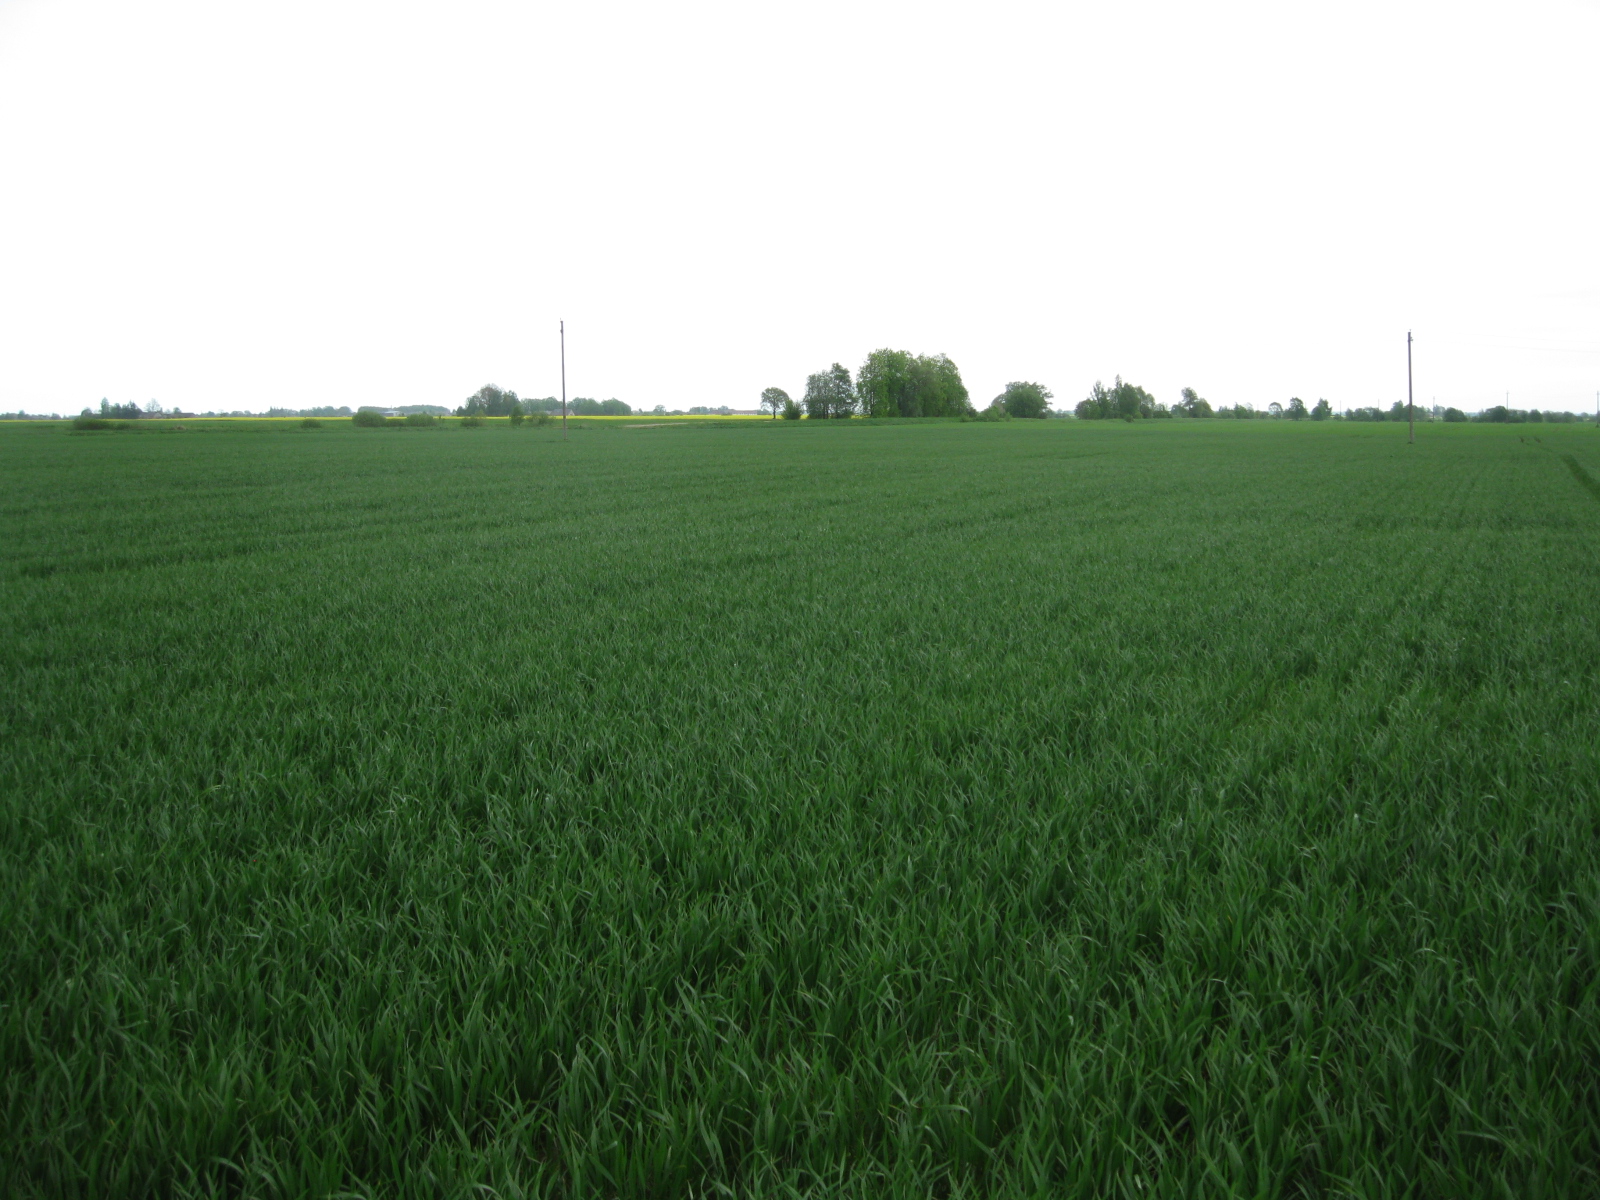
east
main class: Cropland
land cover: Common wheat
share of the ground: > 75 %
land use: Agriculture (excluding fallow land and kitchen gardens)
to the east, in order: Common wheat; Electric lines; Common wheat; Grass margins; Paved roads, cycling and walking lanes; Grass margins; Common wheat
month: May
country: LT
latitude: 56.2453
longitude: 23.4201
